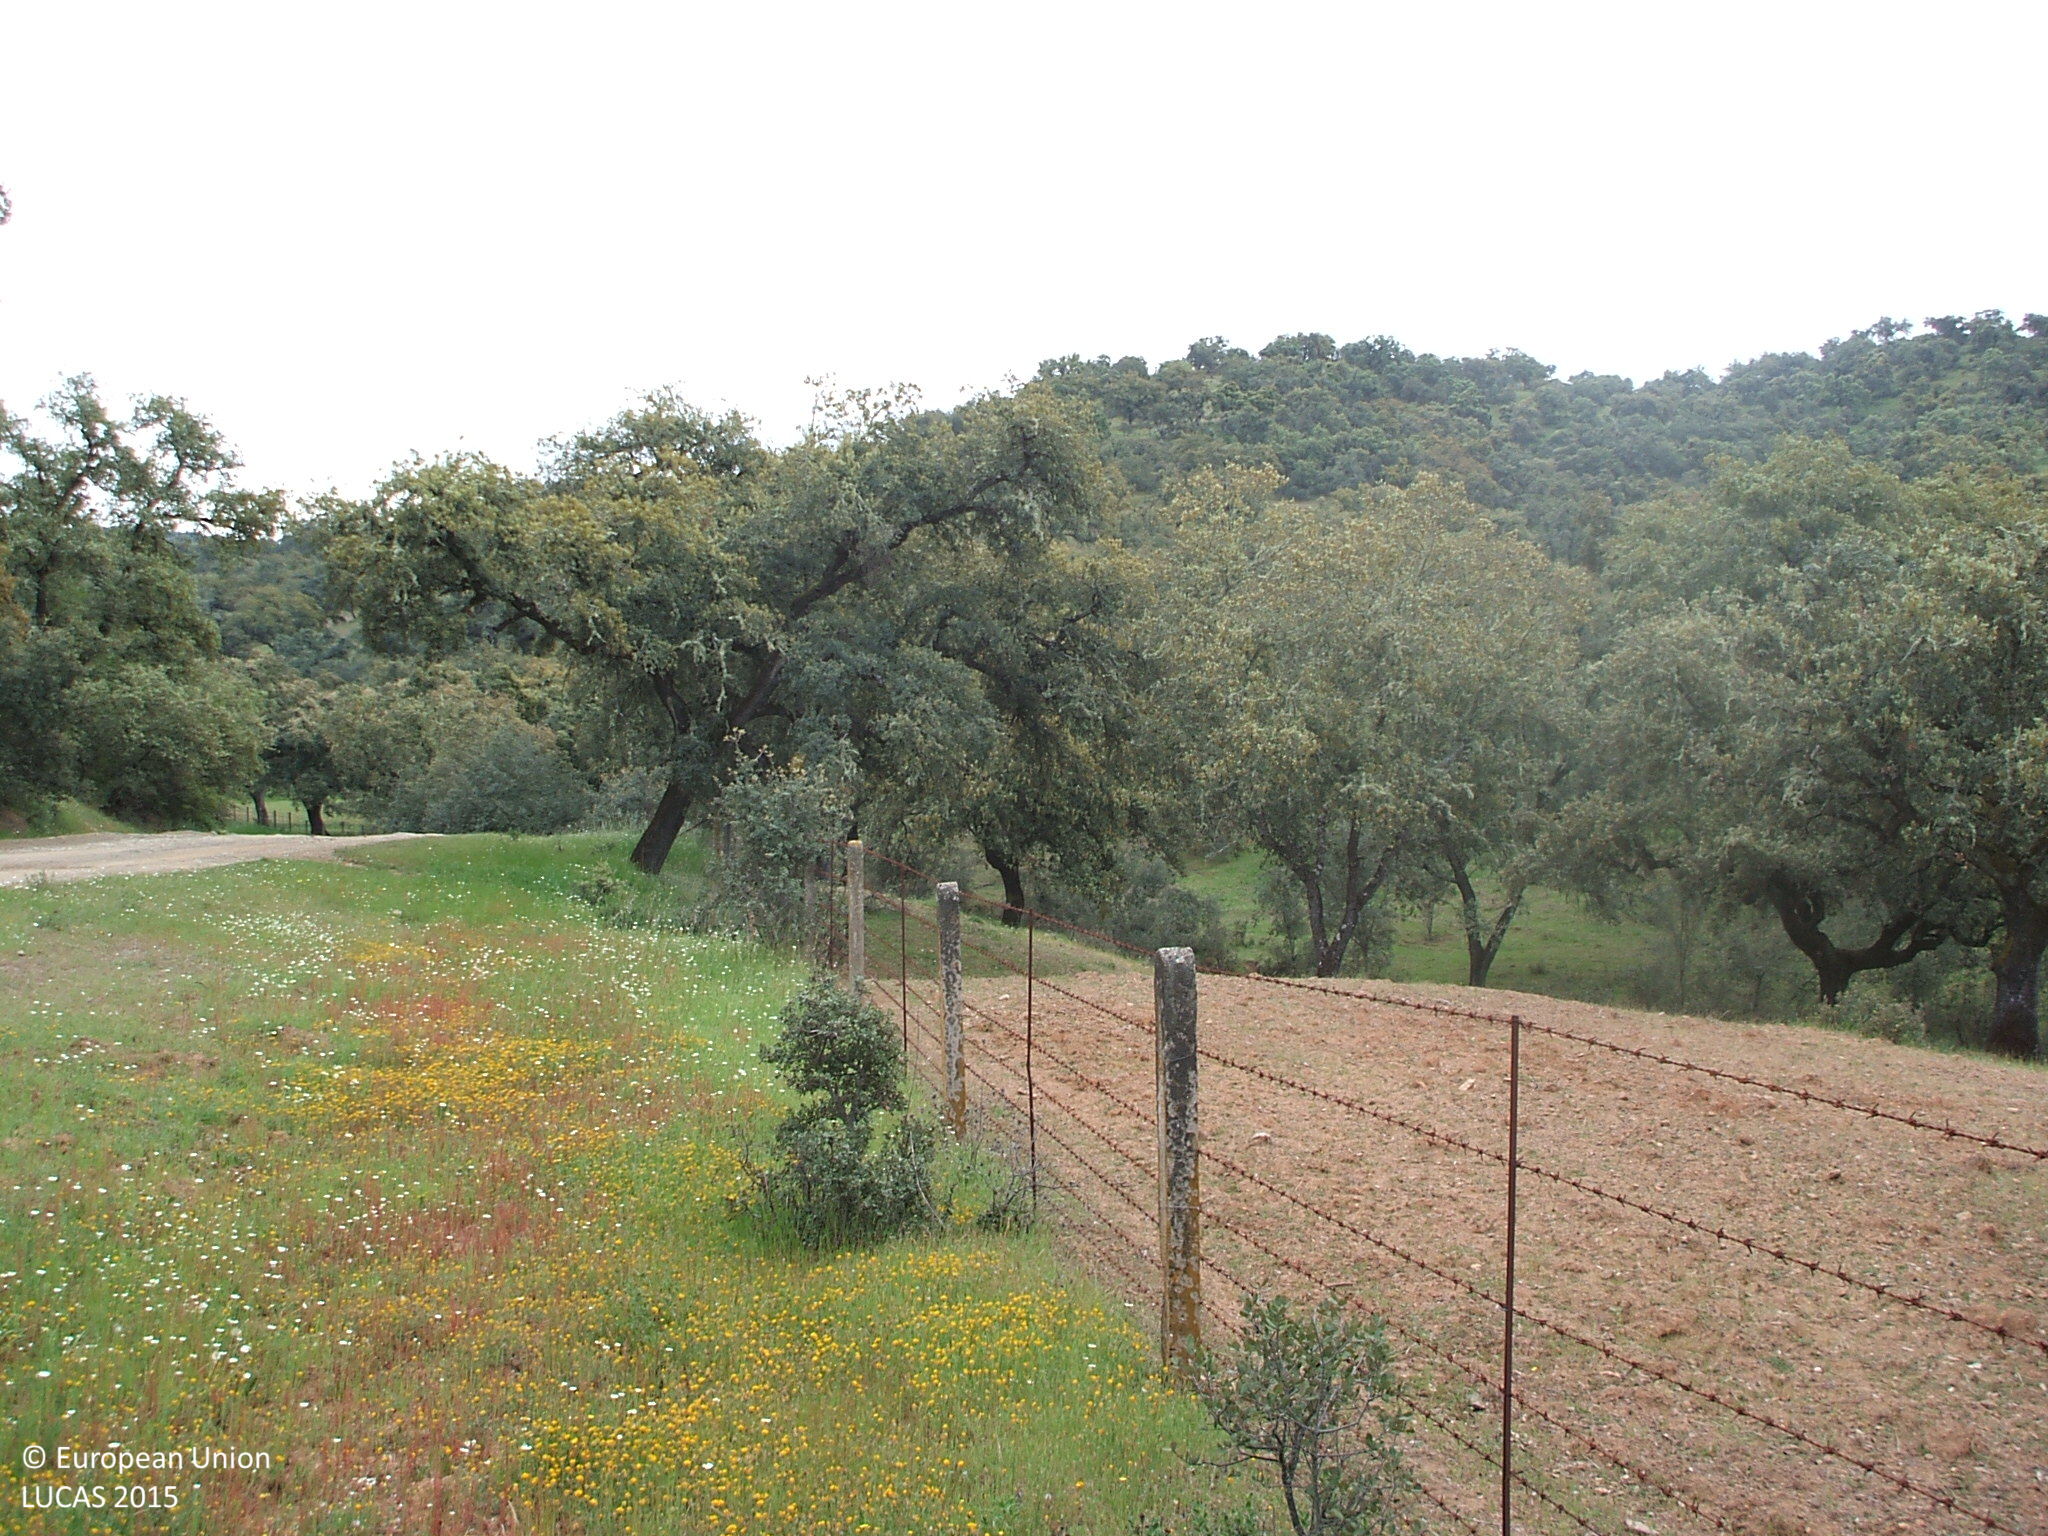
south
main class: Woodland
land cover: Broadleaved woodland
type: broadleaved evergreen forest
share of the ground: 25 - 50 %
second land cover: Grassland without tree/shrub cover
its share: > 75 %
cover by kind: herbaceous plants 60 %, broadleaved forest trees 40 %
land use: Forestry
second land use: Agriculture (excluding fallow land and kitchen gardens)
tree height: > 5 m
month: April
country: ES
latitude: 38.0630
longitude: -5.6568
